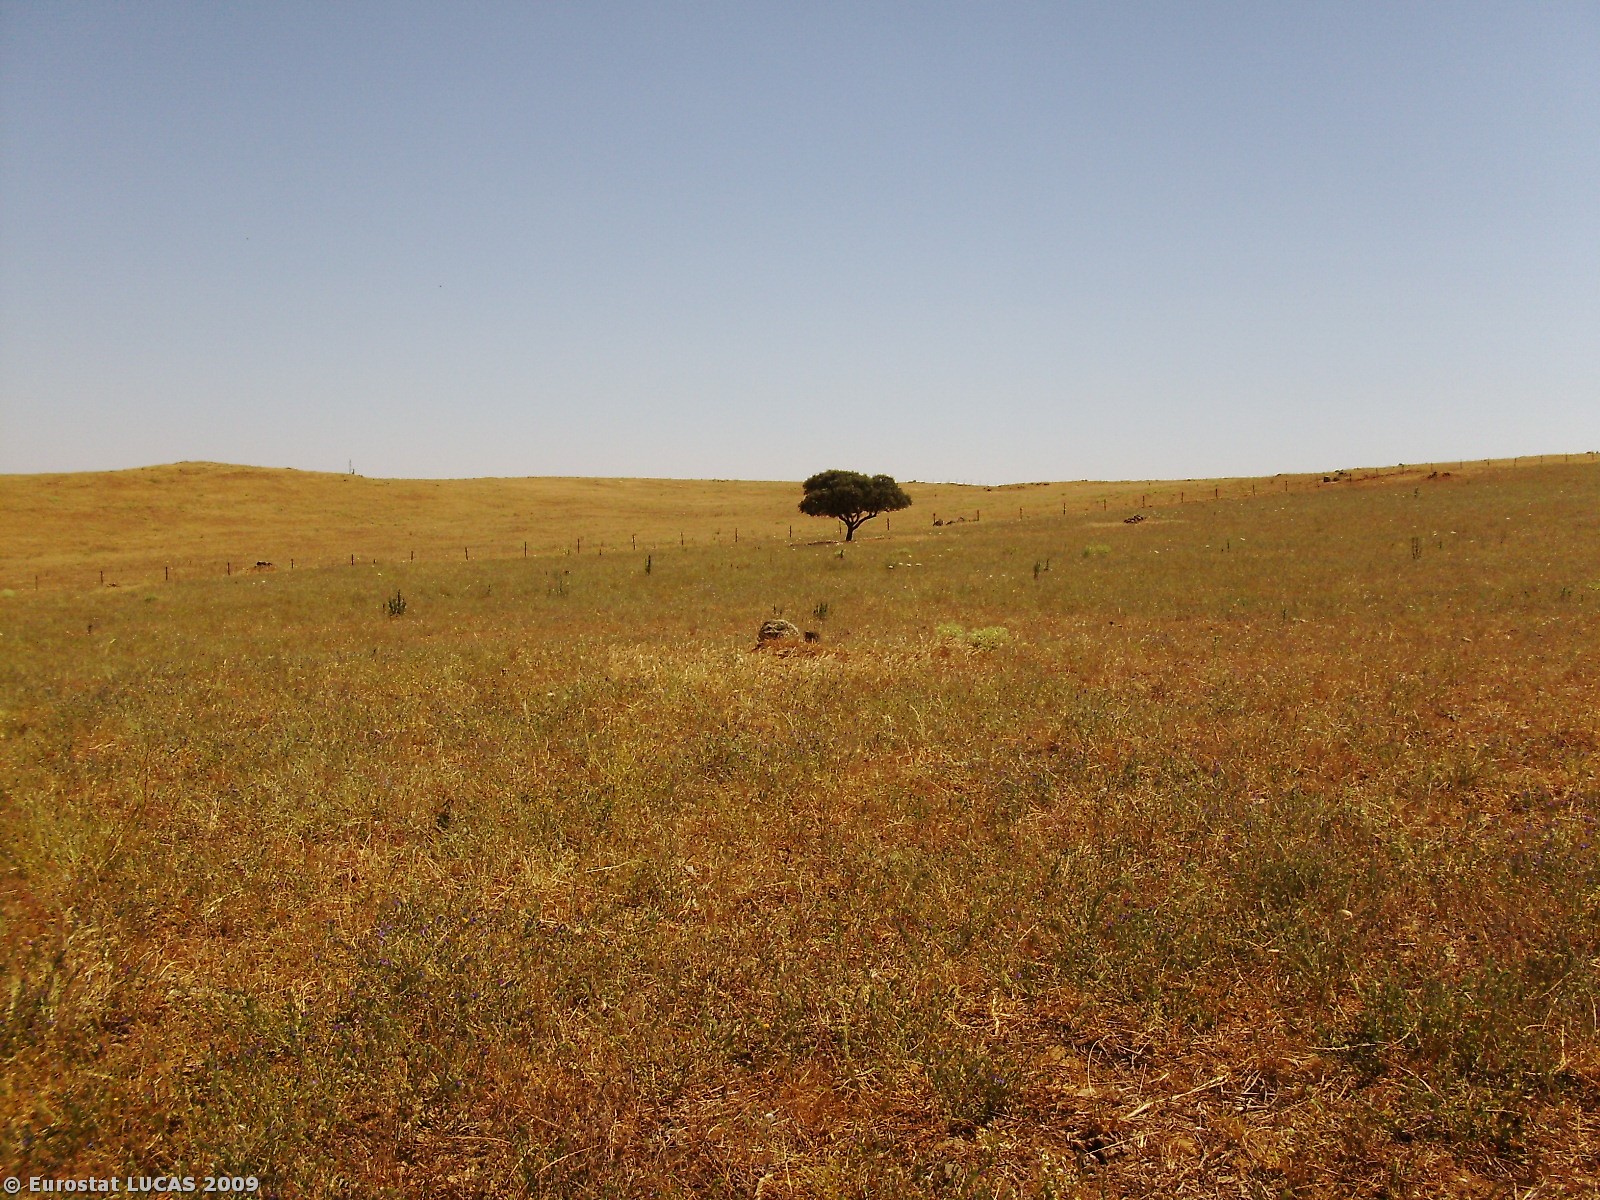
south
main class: Grassland
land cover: Spontaneously vegetated surfaces
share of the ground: > 75 %
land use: Fallow land
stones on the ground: 10 - 25 %
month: May
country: PT
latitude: 38.9084
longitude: -7.3653
